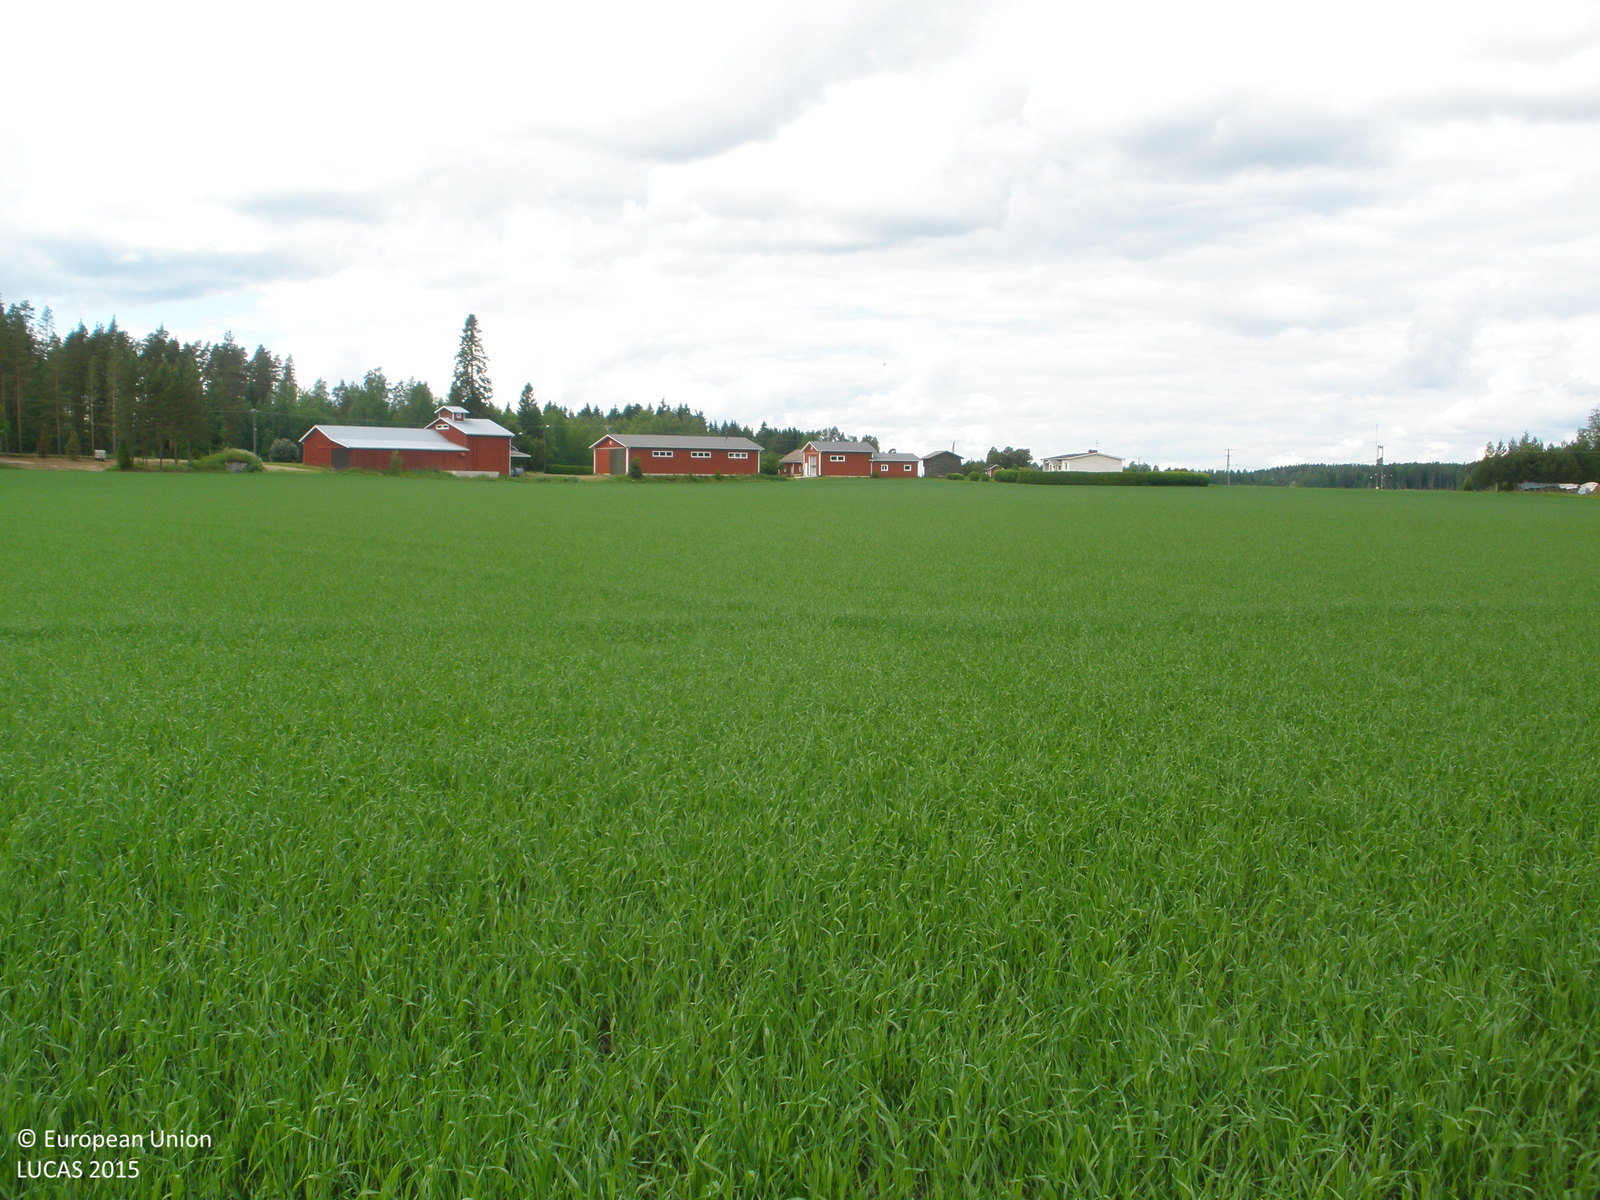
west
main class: Cropland
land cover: Oats
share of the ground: > 75 %
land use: Agriculture (excluding fallow land and kitchen gardens)
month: June
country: FI
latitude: 61.0318
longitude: 23.2762
